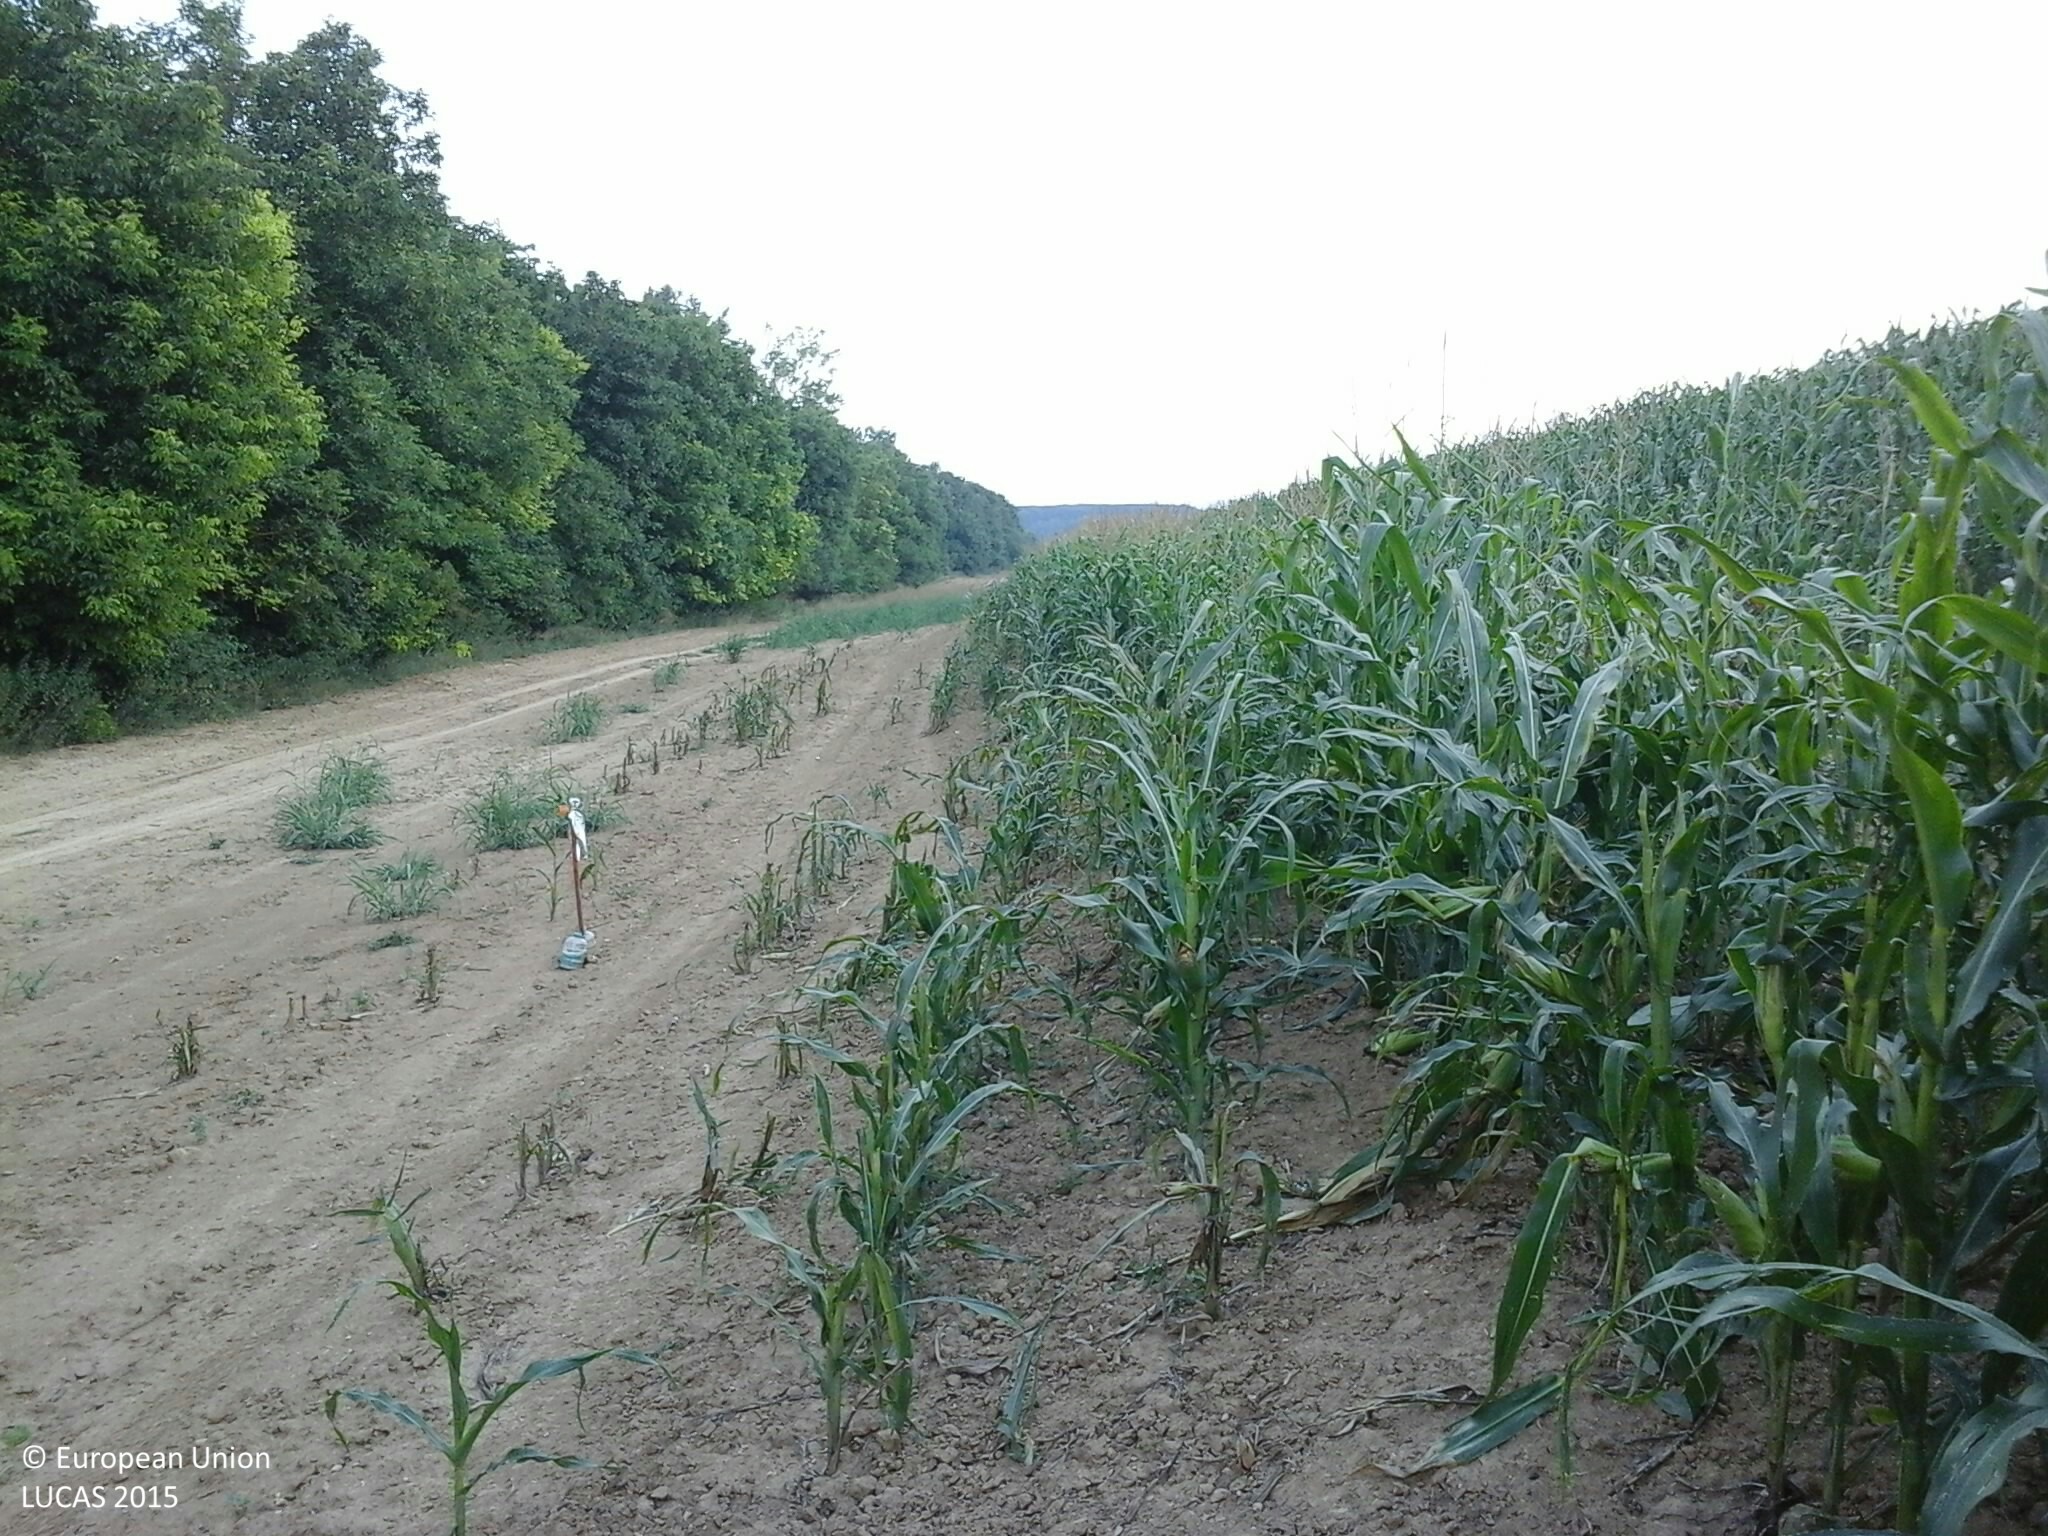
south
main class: Cropland
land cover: Maize
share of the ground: > 75 %
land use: Agriculture (excluding fallow land and kitchen gardens)
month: August
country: HU
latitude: 45.9734
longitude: 18.3059
